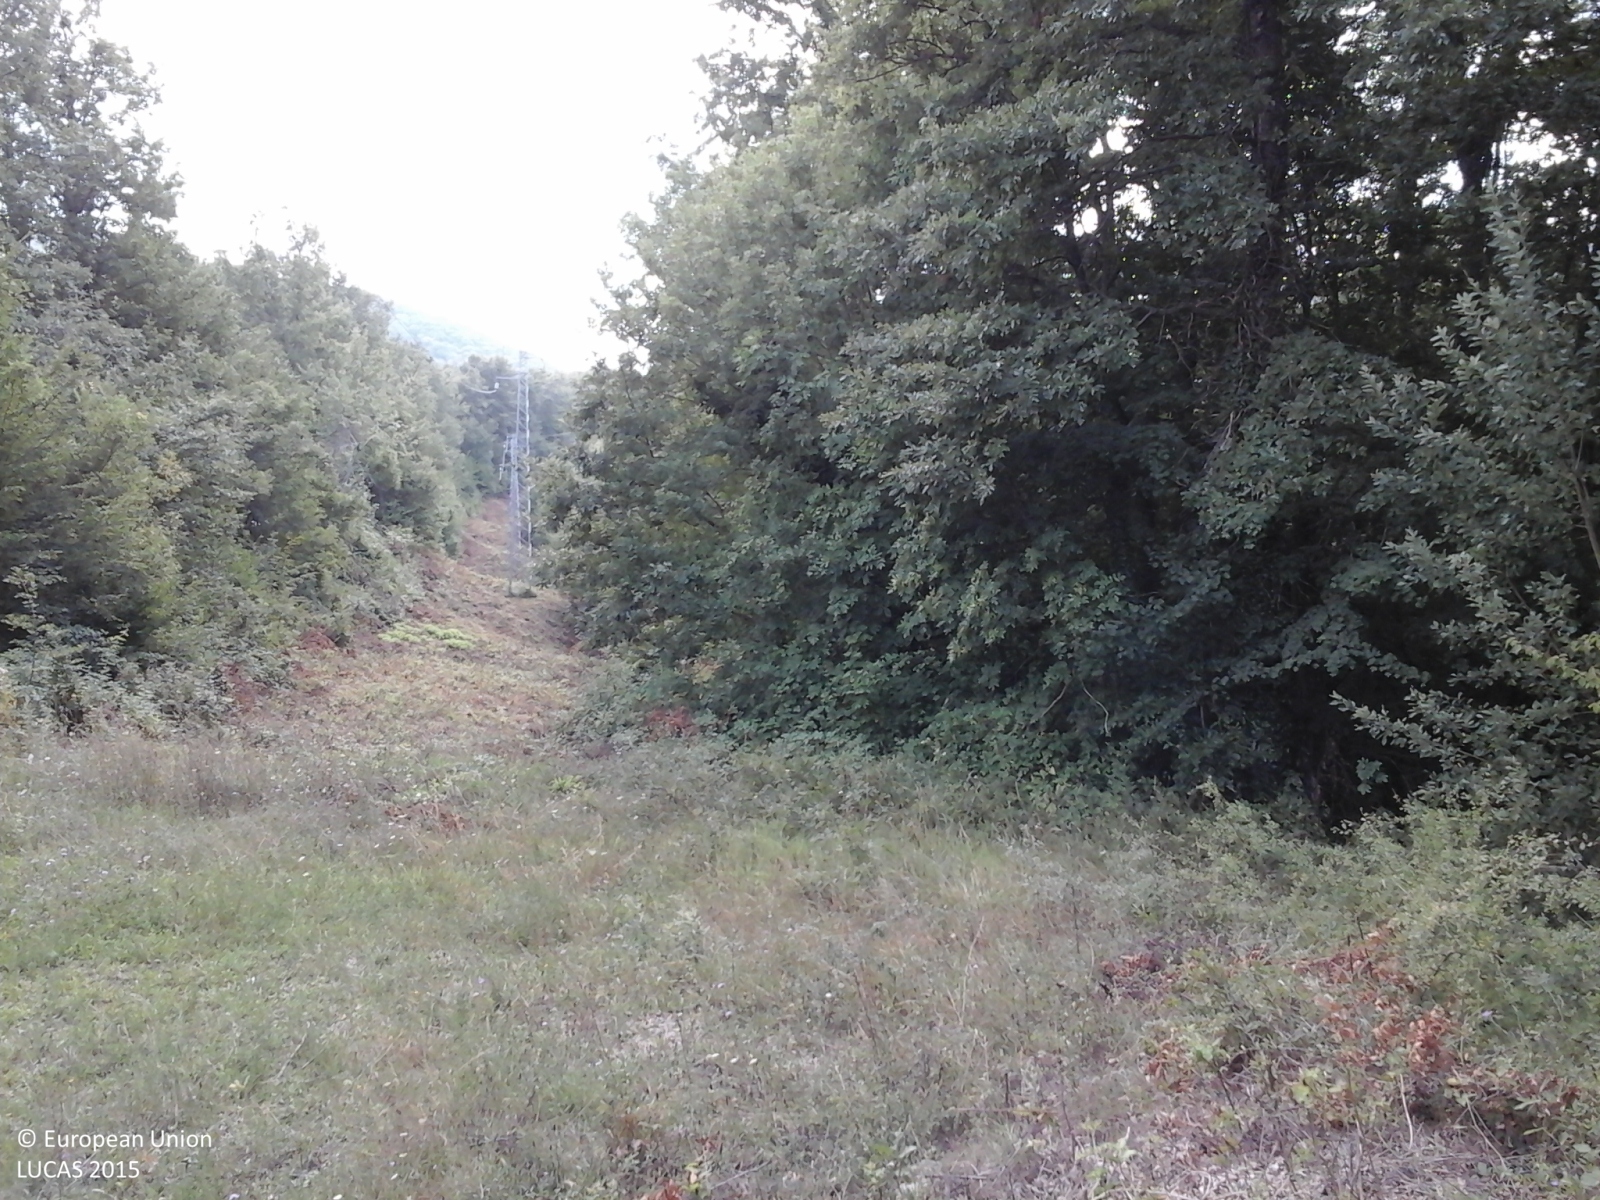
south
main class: Woodland
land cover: Broadleaved woodland
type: thermophilous deciduous forest
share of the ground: > 75 %
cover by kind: broadleaved forest trees 80 %, shrubs 15 %, herbaceous plants 5 %
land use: Semi-natural and natural areas not in use
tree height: > 5 m
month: August
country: IT
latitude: 41.8078
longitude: 14.1864
